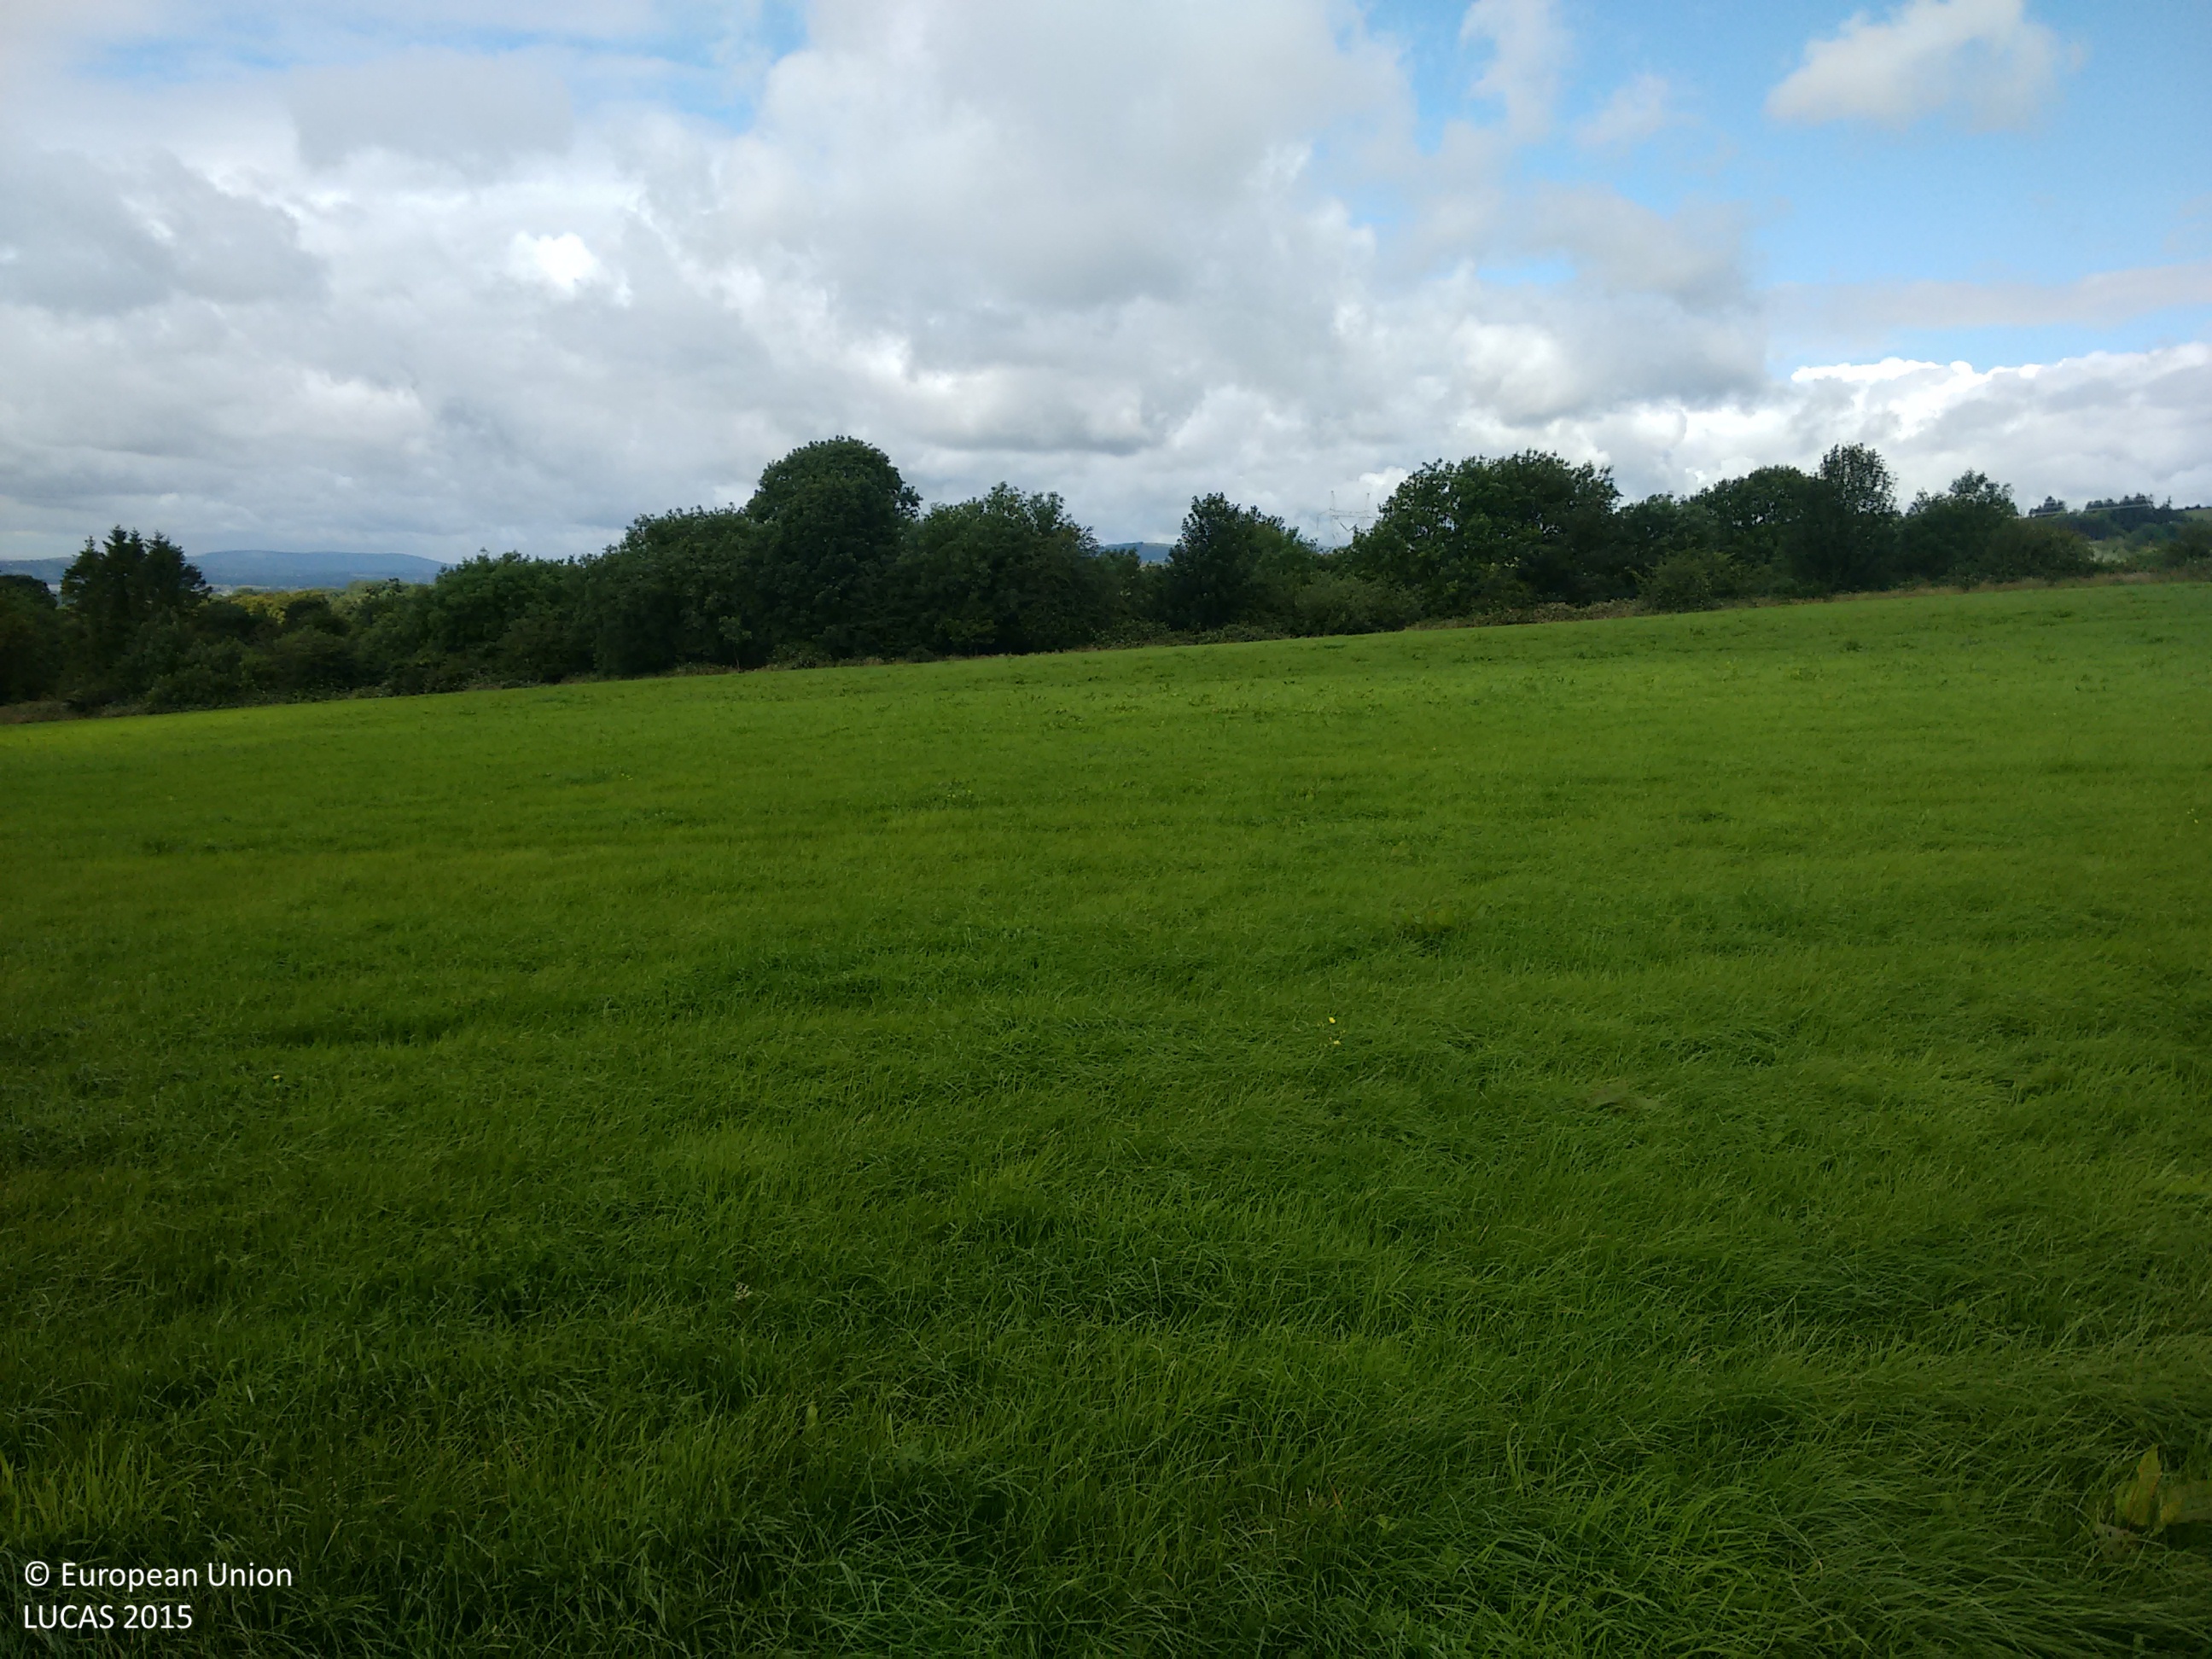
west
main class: Grassland
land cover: Grassland without tree/shrub cover
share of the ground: > 75 %
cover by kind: herbaceous plants 100 %
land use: Agriculture (excluding fallow land and kitchen gardens)
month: July
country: IE
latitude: 52.8106
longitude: -8.3625
